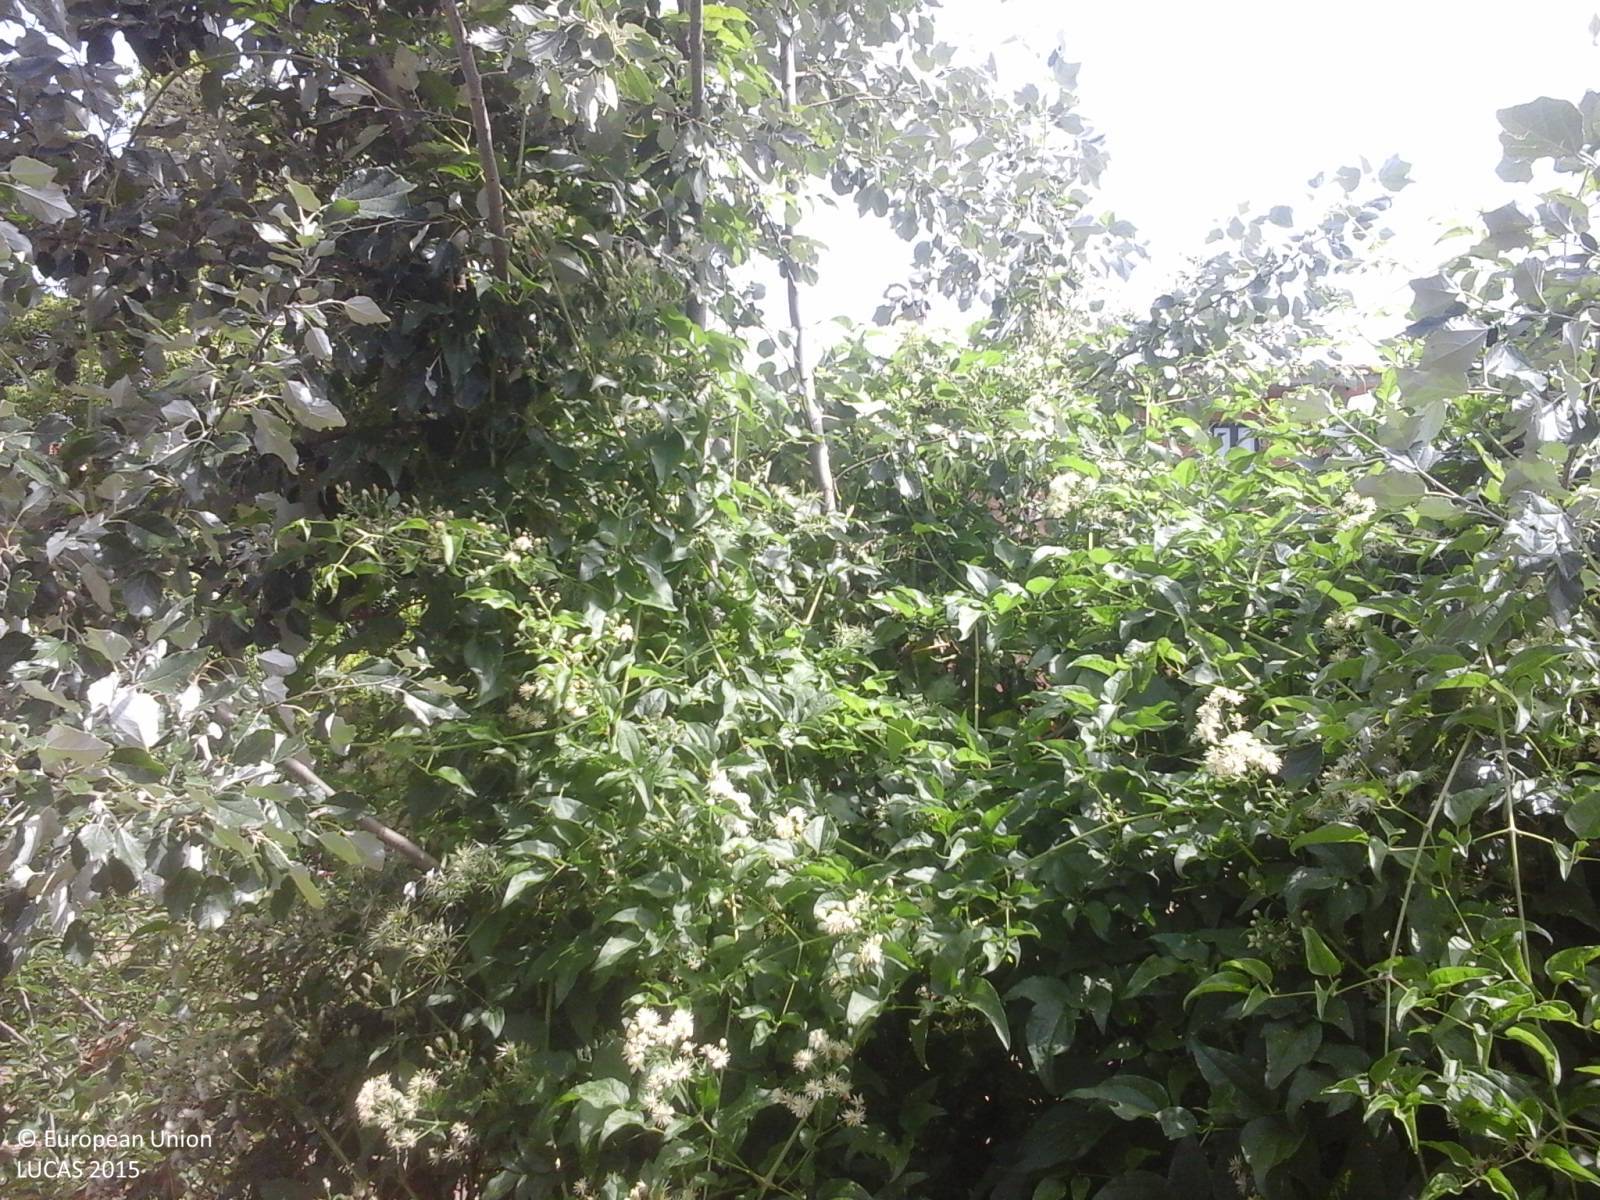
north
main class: Shrubland
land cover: Shrubland without tree cover
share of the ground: > 75 %
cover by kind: shrubs 50 %, herbaceous plants 40 %, unconsolidated bare surface 10 %
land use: Abandoned areas
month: June
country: IT
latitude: 39.1543
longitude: 8.7465
